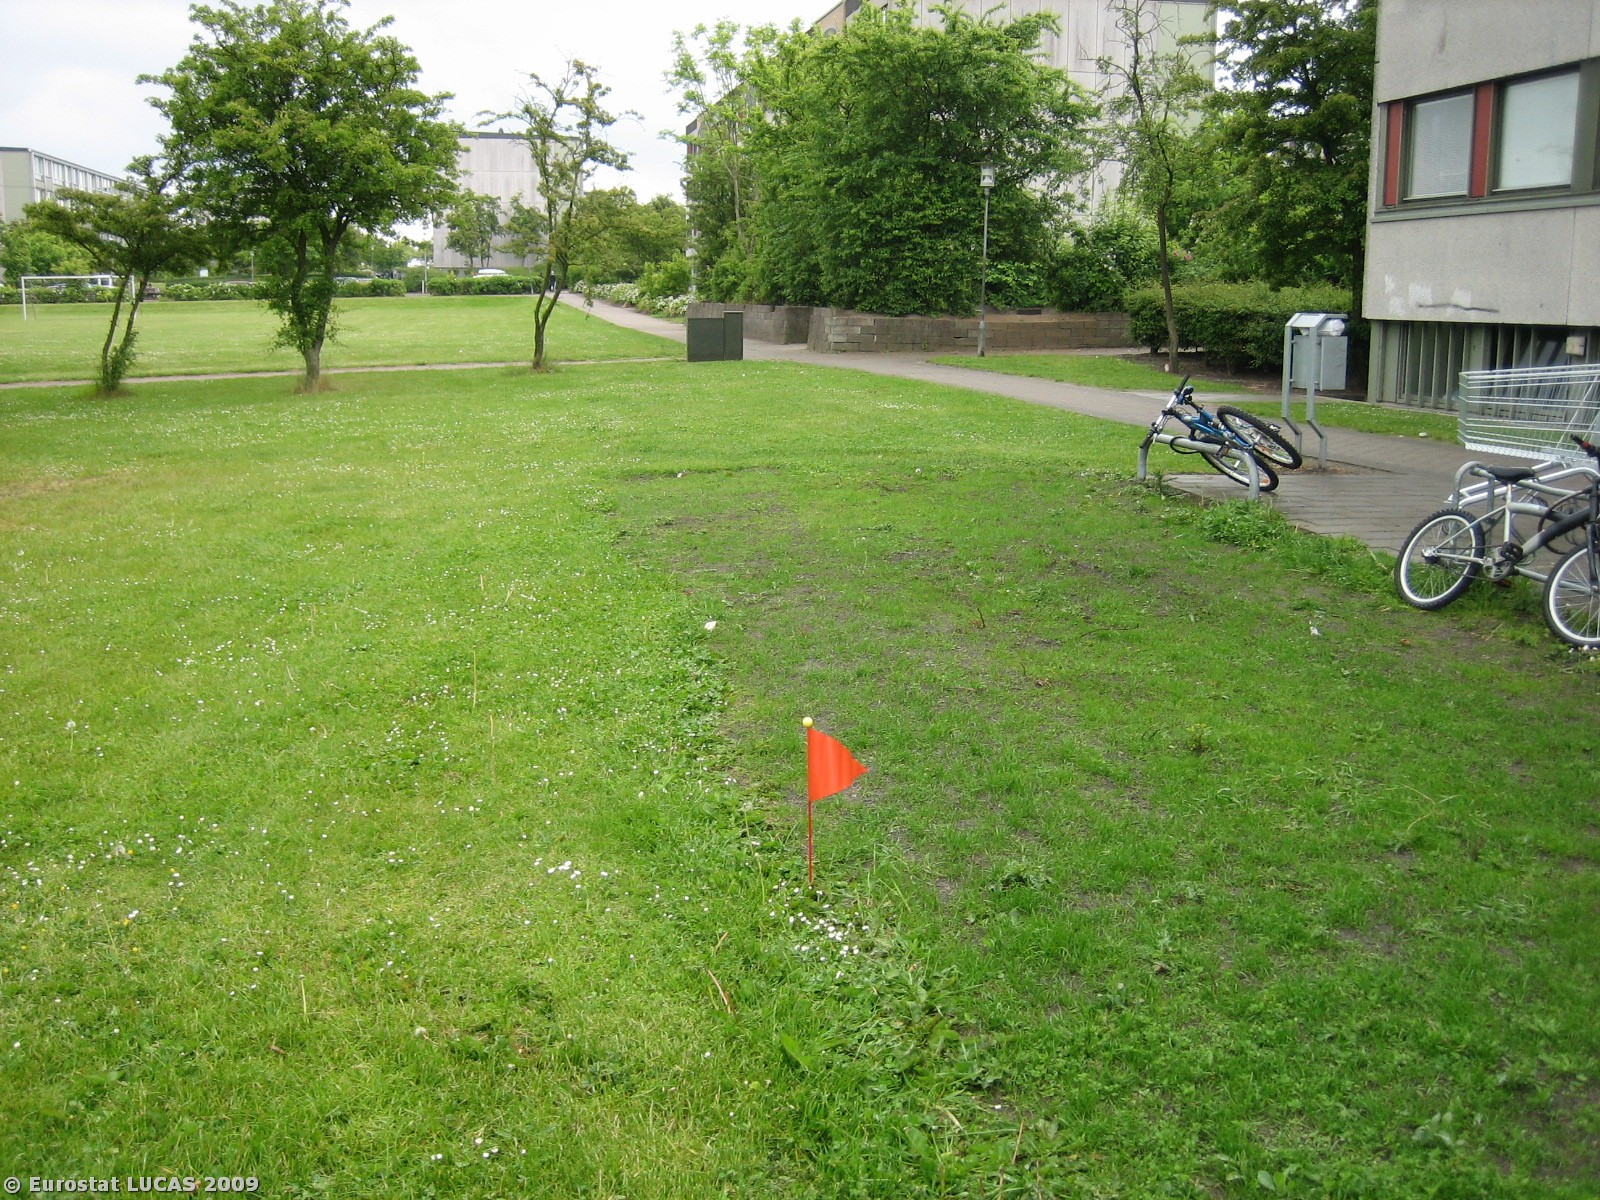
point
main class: Grassland
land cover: Grassland without tree/shrub cover
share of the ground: > 75 %
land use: Residential
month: June
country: DK
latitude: 56.1157
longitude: 10.1446
